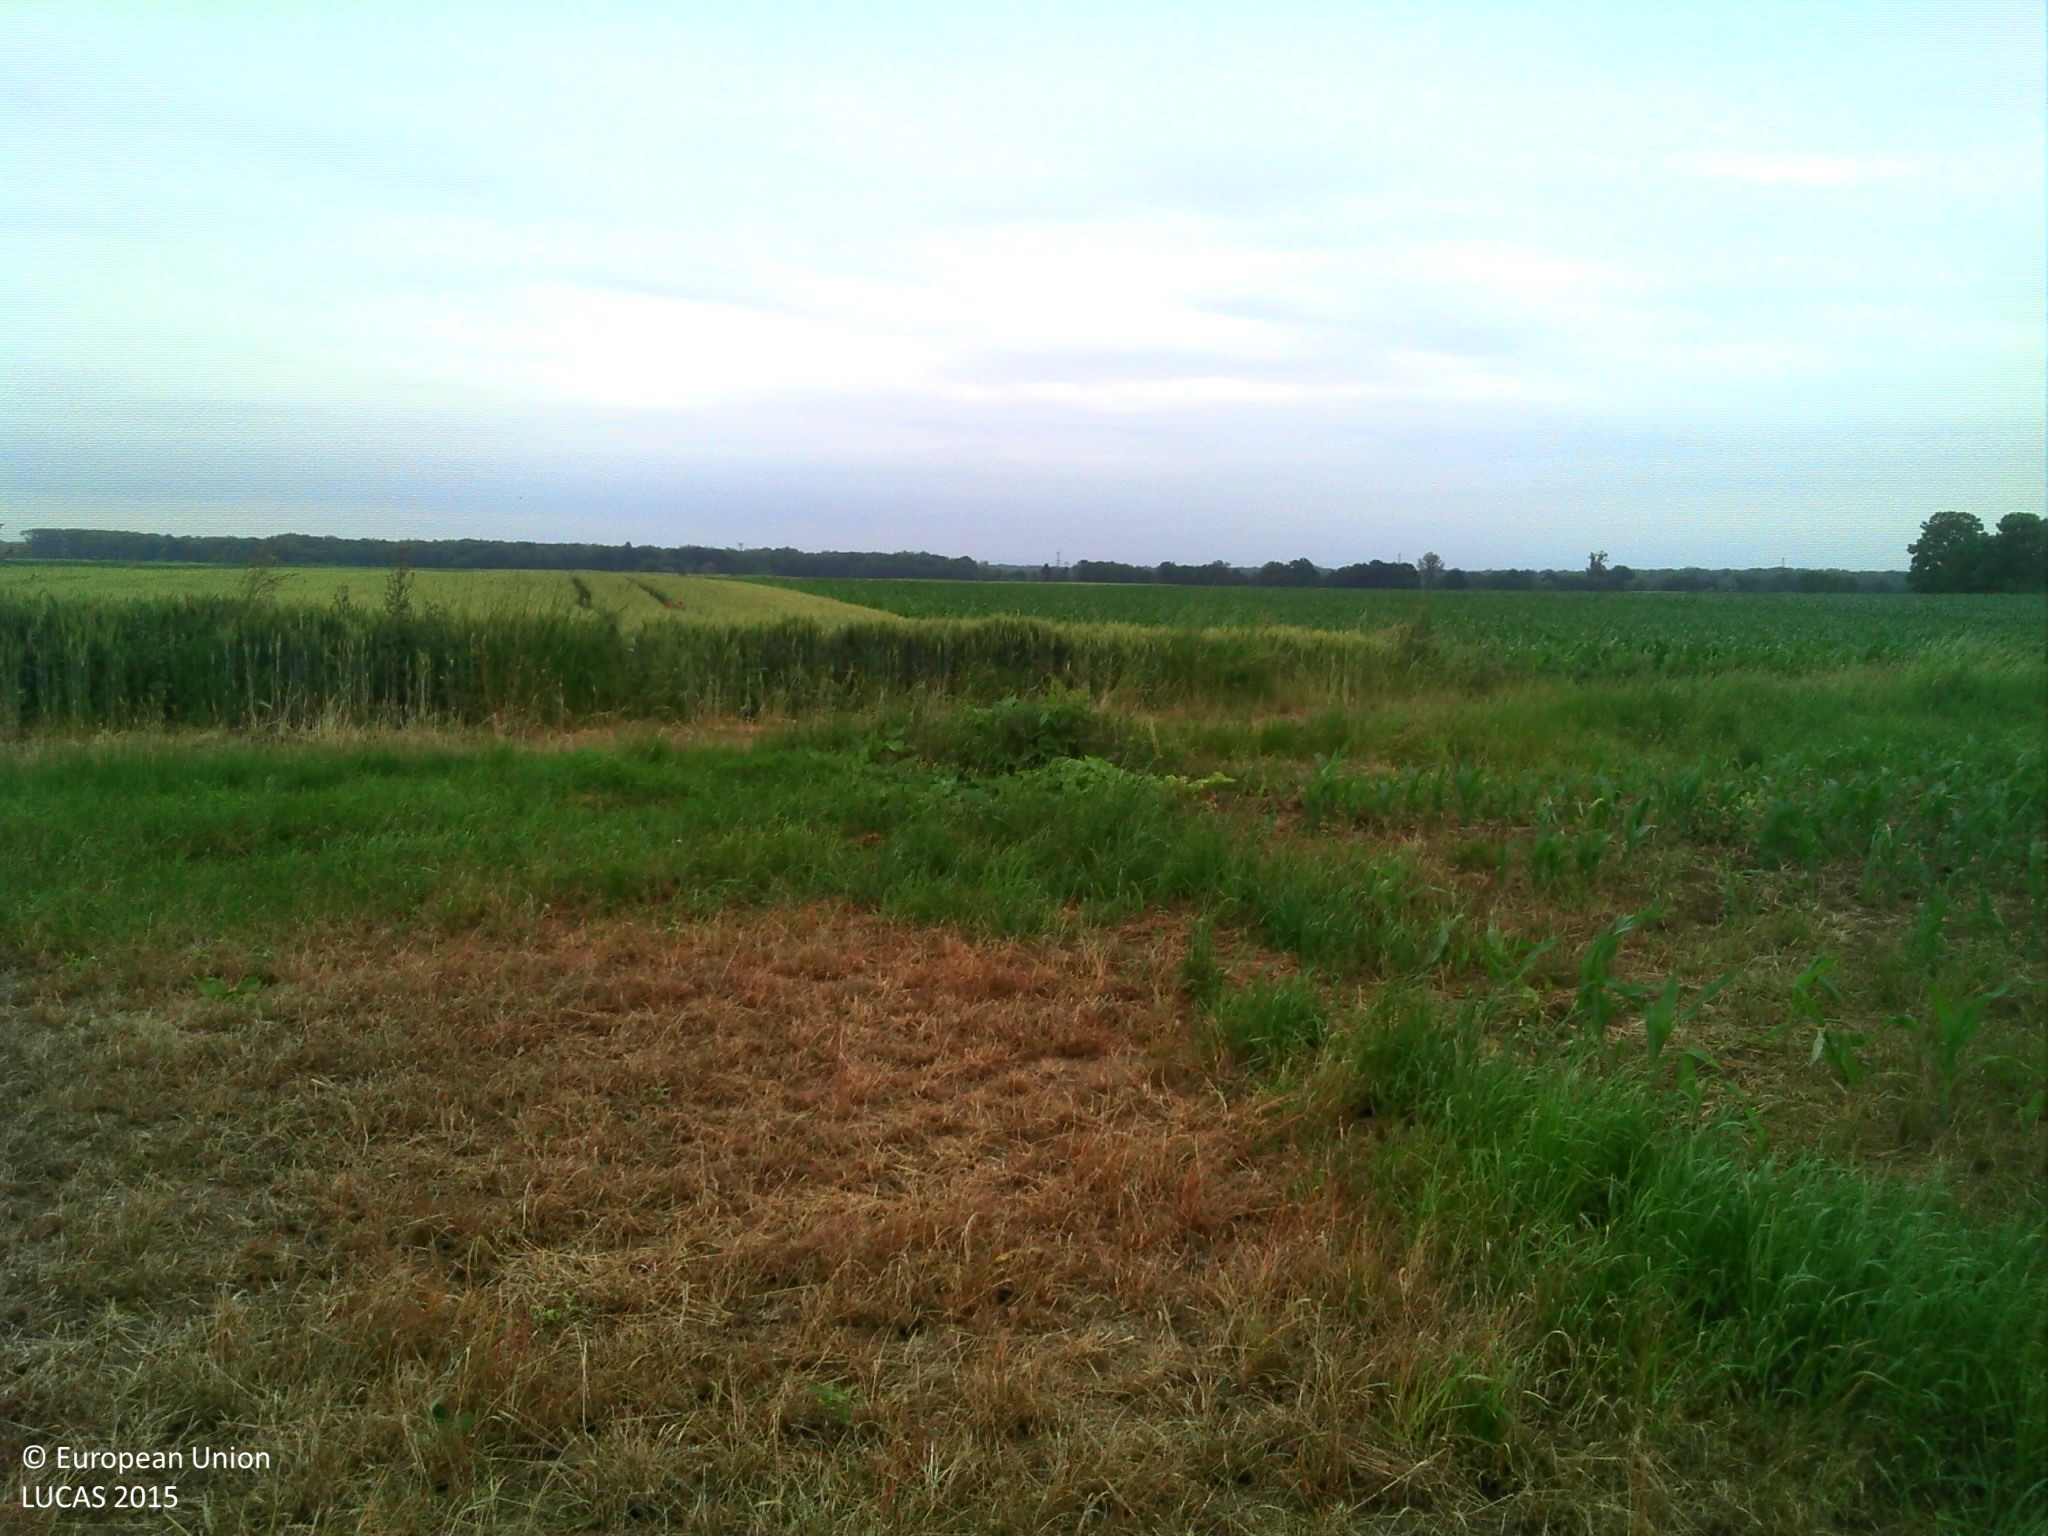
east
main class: Grassland
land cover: Grassland without tree/shrub cover
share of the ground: > 75 %
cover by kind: herbaceous plants 100 %
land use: Agriculture (excluding fallow land and kitchen gardens)
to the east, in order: Grassland without tree/shrub cover; Grass margins; Tracks; Grass margins; Common wheat; Tracks; Maize
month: June
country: FR
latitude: 48.4113
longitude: 7.5015
